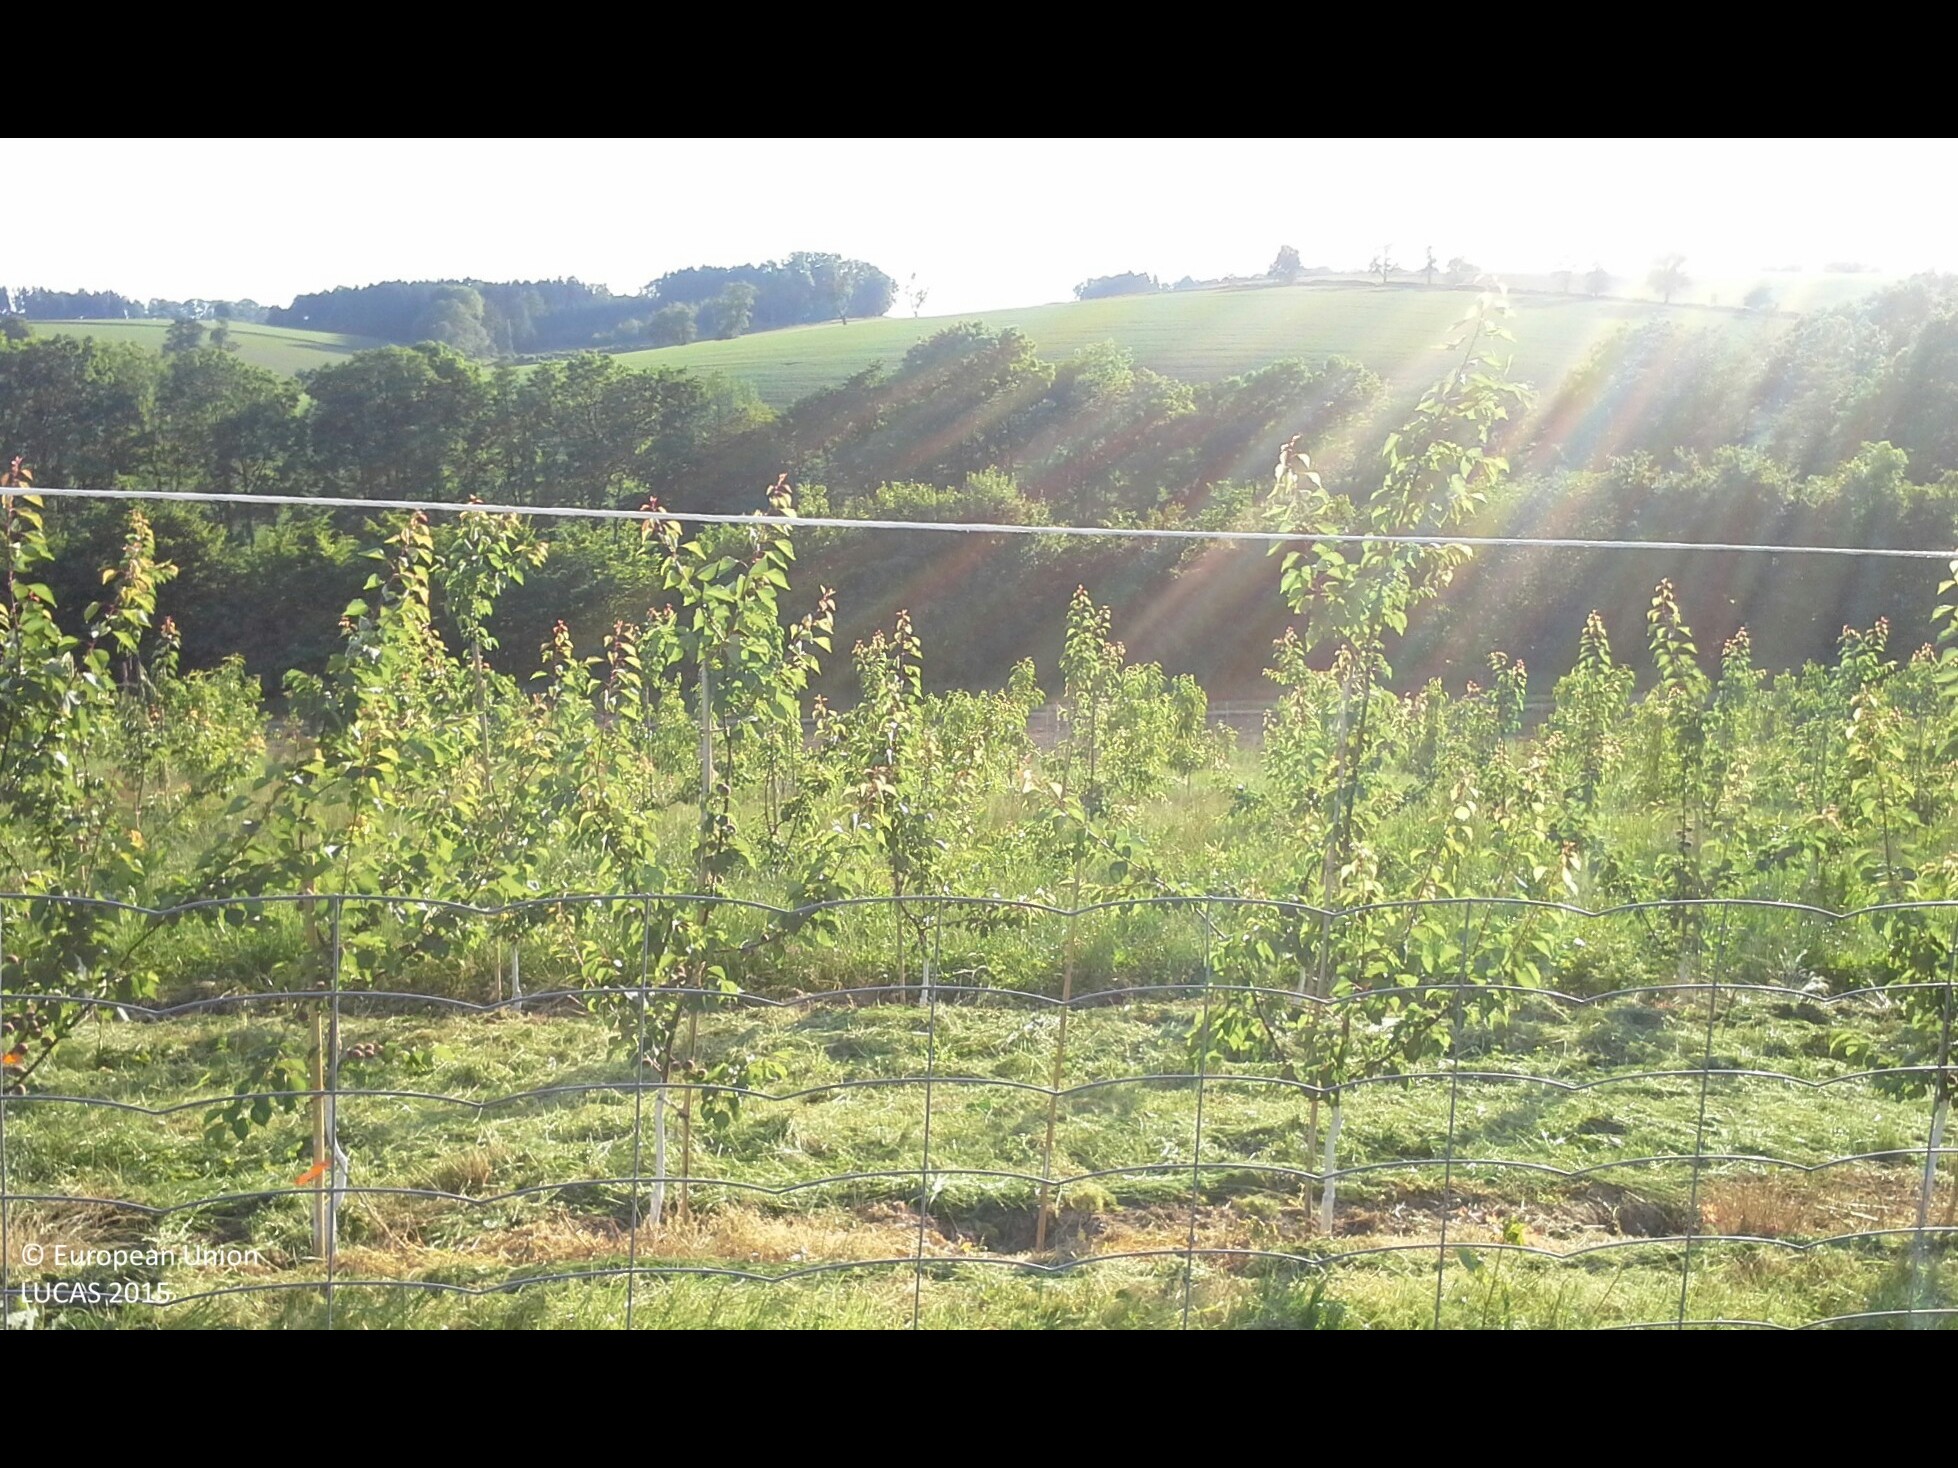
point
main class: Cropland
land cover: Other fruit trees and berries
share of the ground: 25 - 50 %
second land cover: Grassland without tree/shrub cover
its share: > 75 %
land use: Agriculture (excluding fallow land and kitchen gardens)
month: May
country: AT
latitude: 48.1740
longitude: 14.3437
